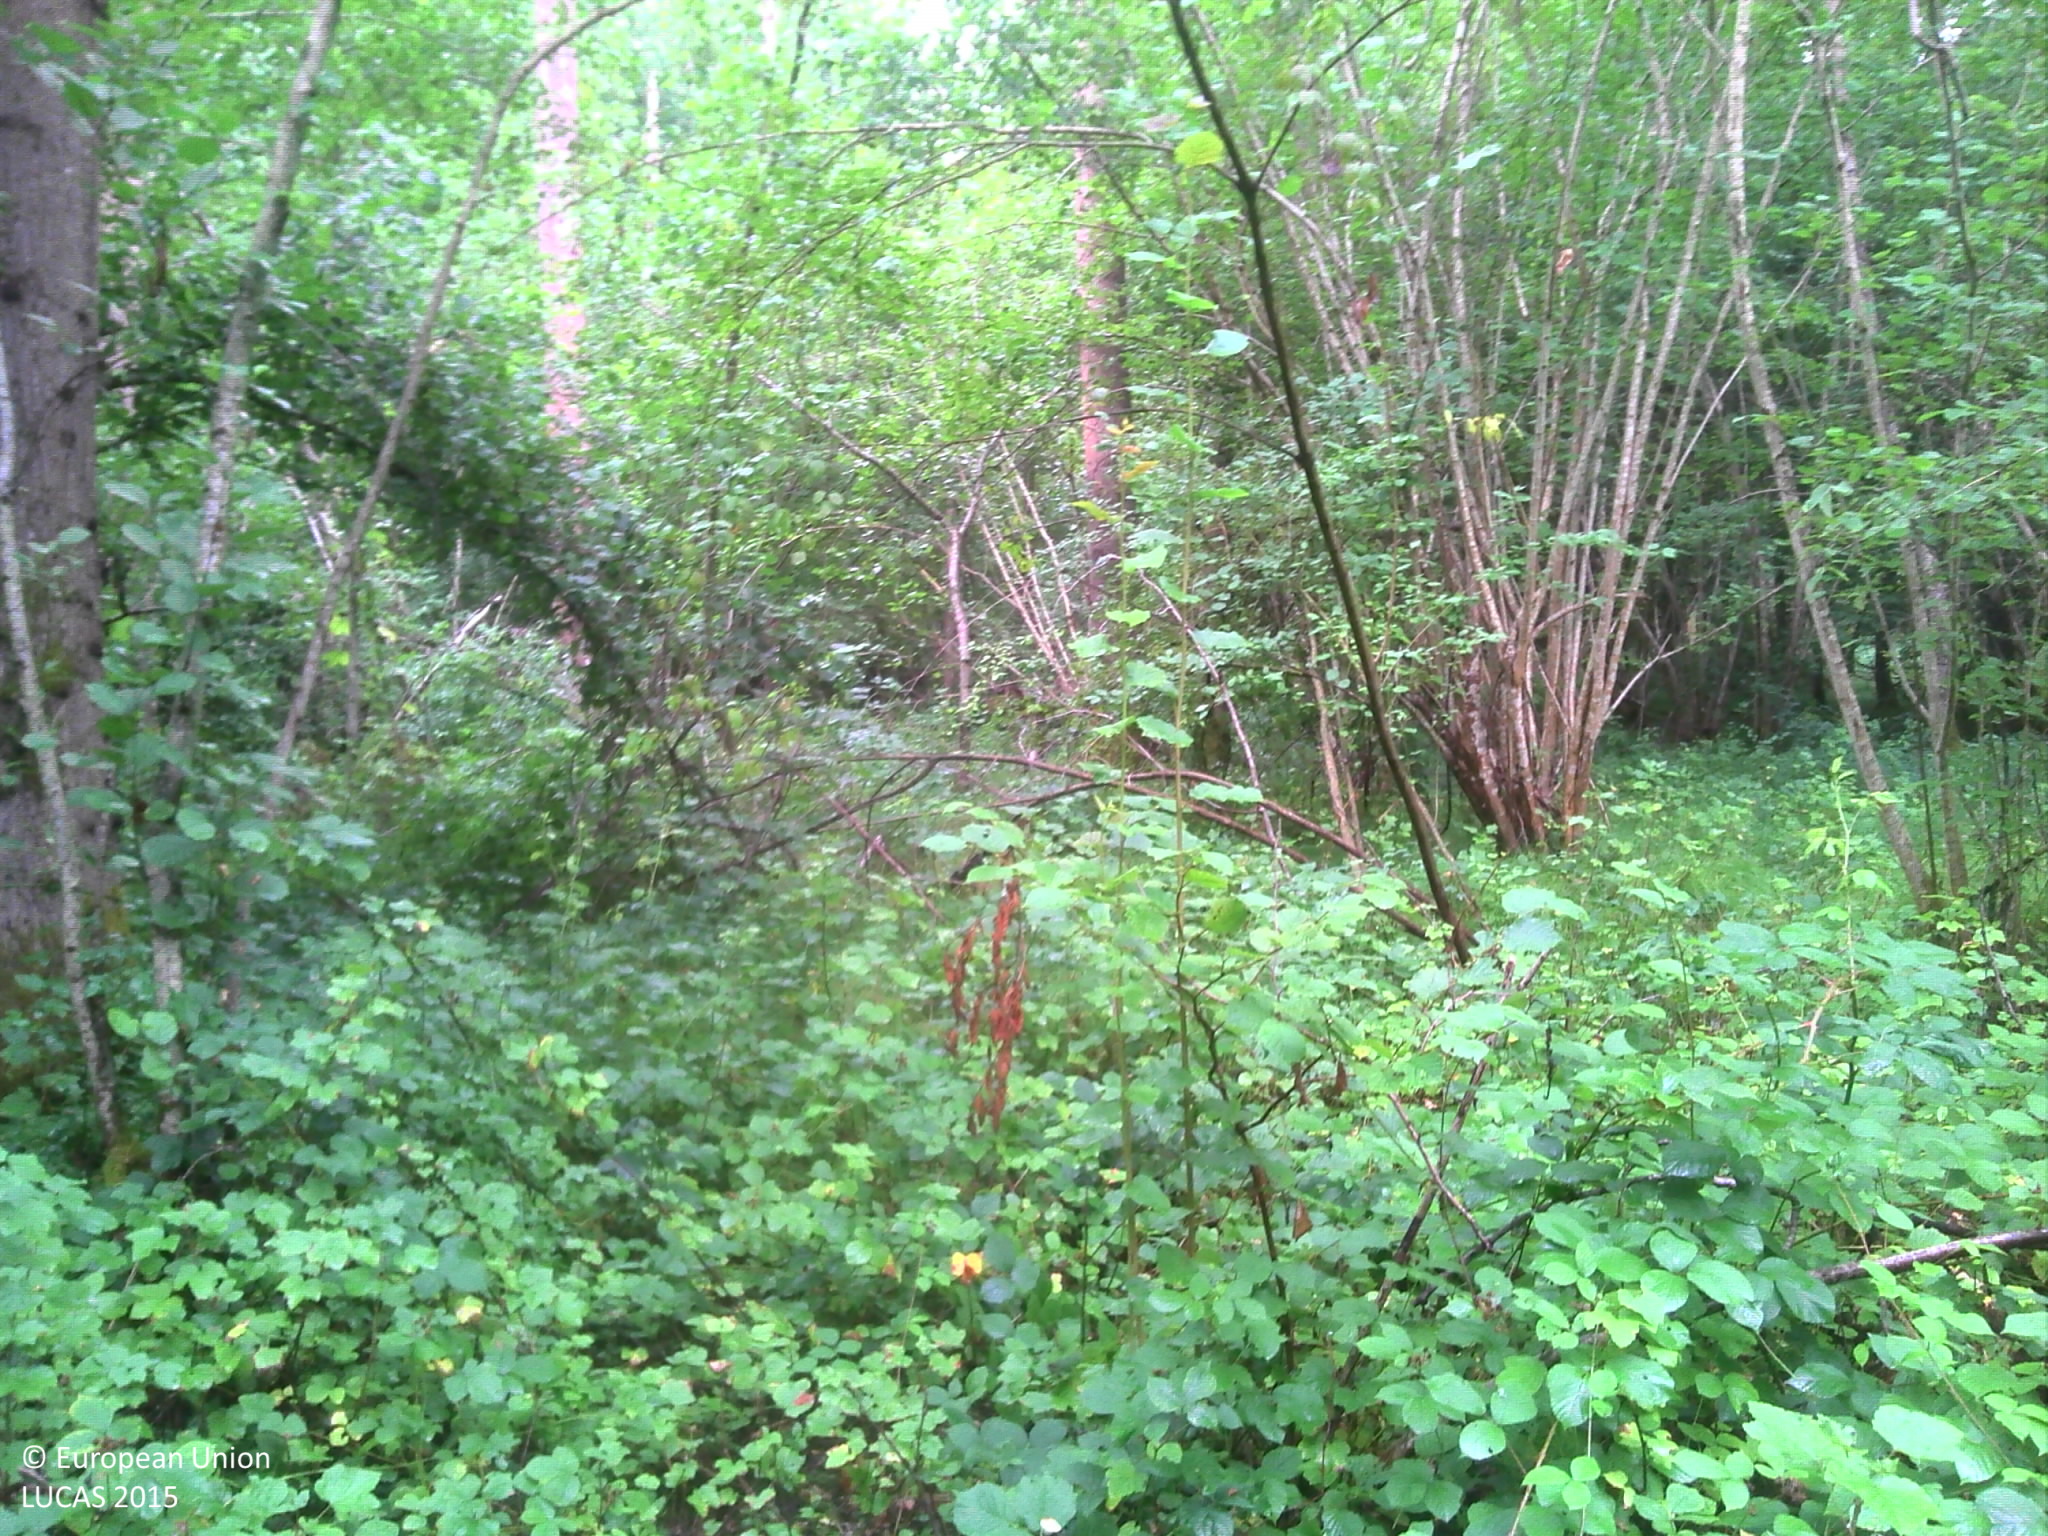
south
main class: Woodland
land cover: Broadleaved woodland
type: non-riverine alder, birch or aspen forest
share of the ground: > 75 %
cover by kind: broadleaved forest trees 75 %, herbaceous plants 20 %, shrubs 5 %
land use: Forestry
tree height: > 5 m
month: July
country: FR
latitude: 46.7223
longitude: 5.0168
